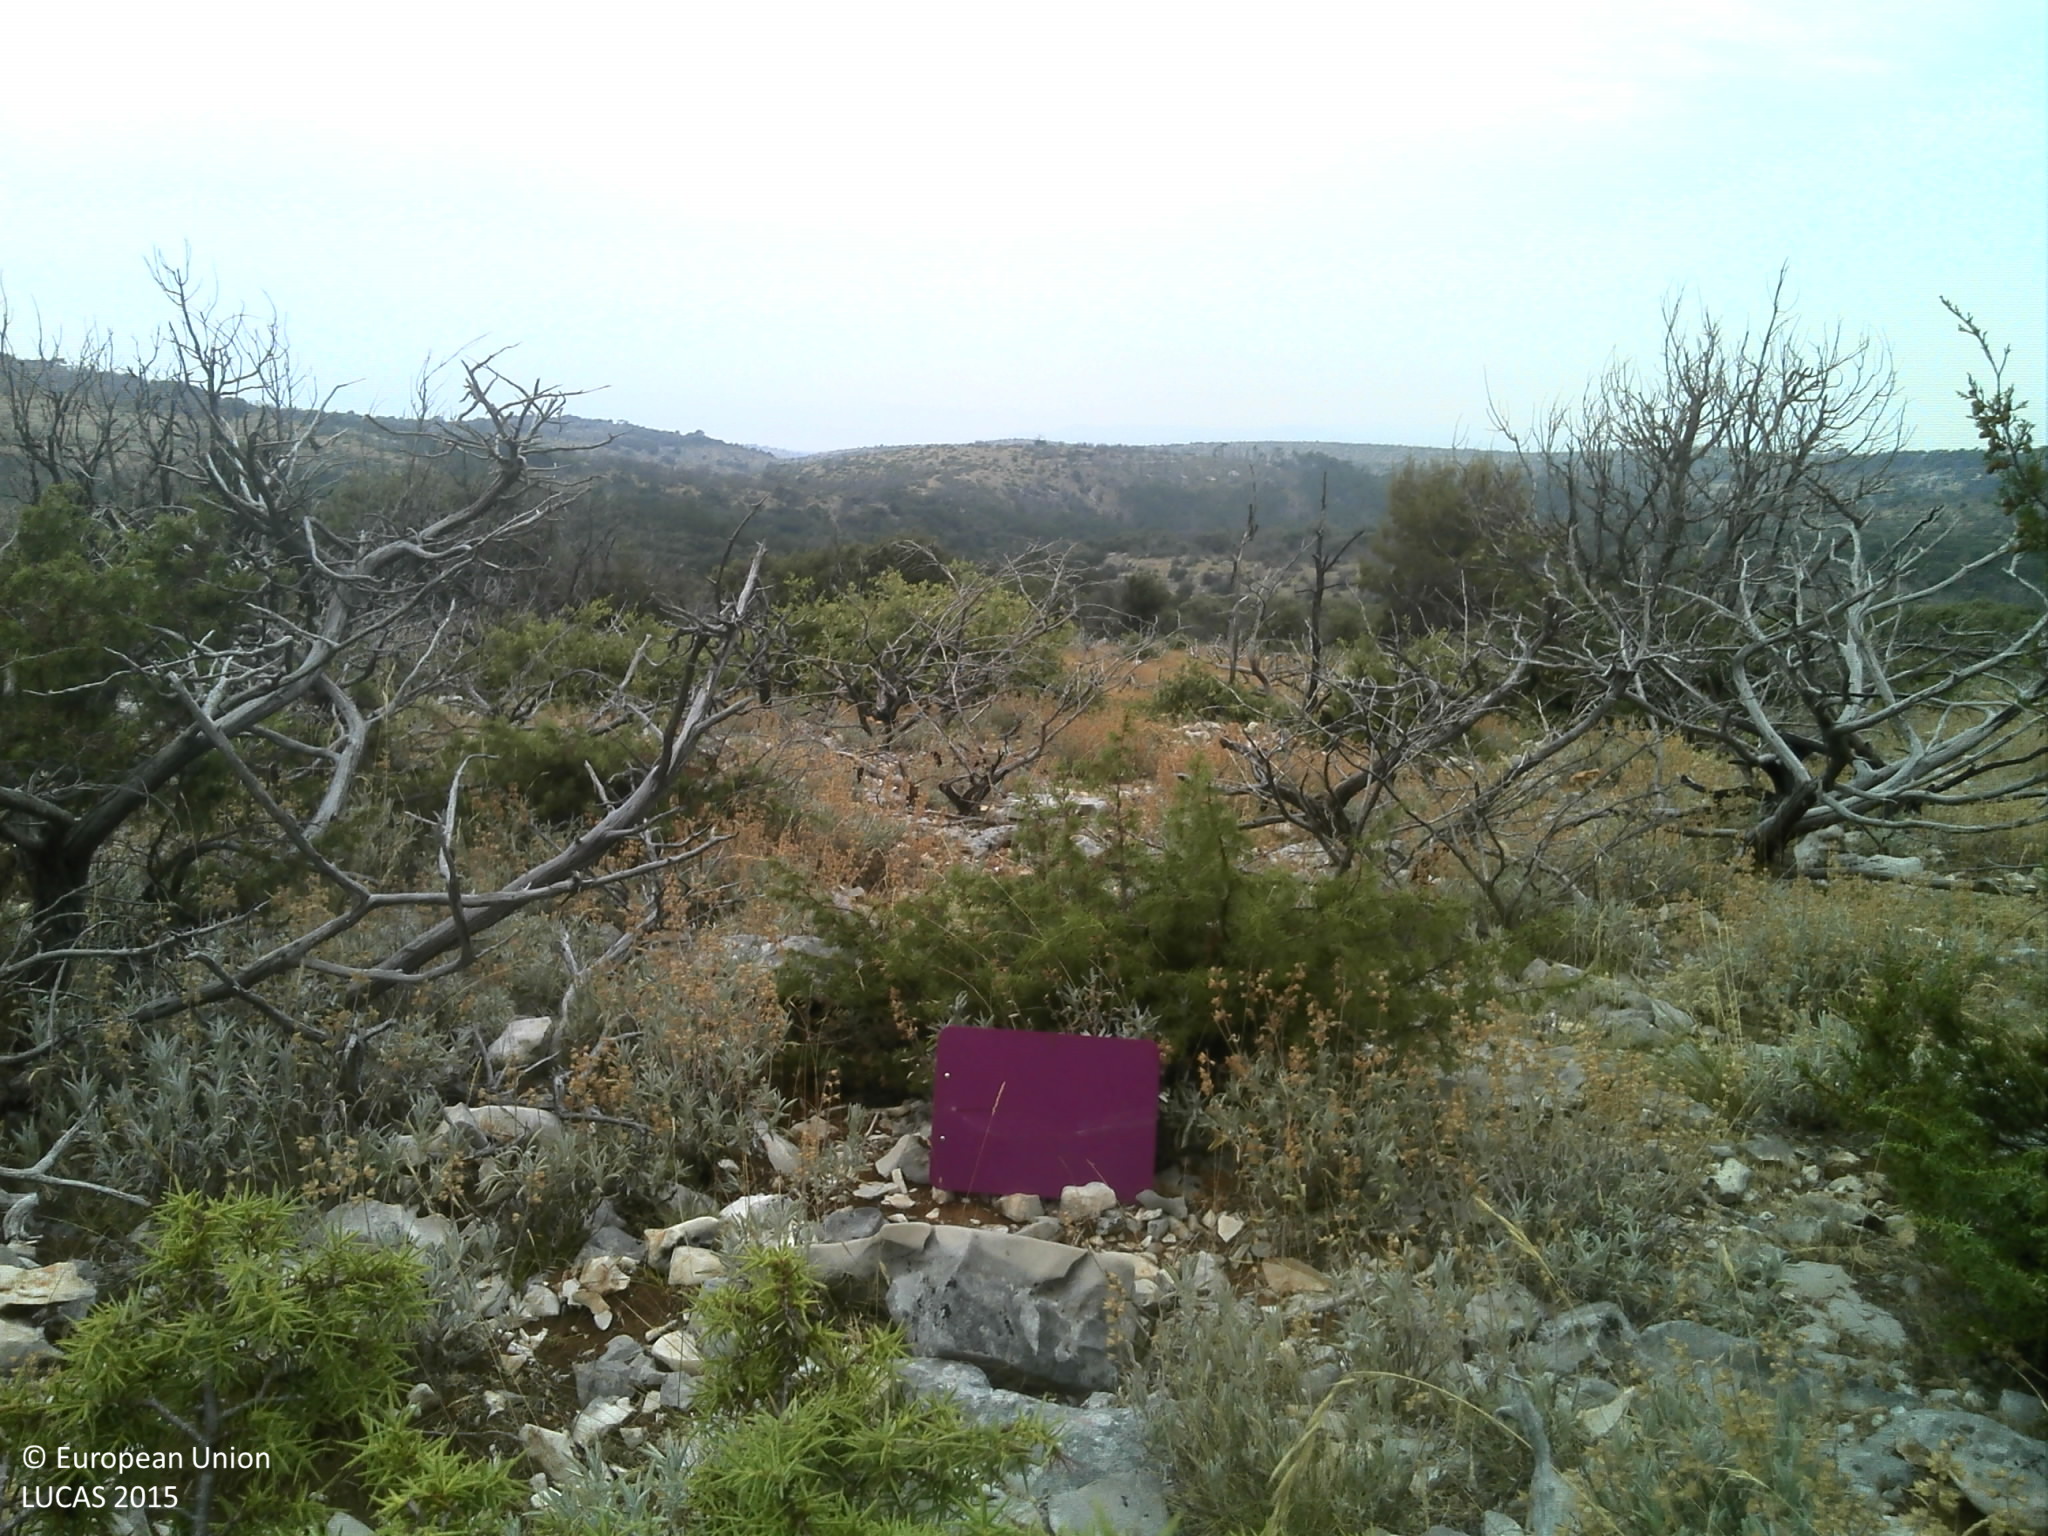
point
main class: Shrubland
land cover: Shrubland with sparse tree cover
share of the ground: > 75 %
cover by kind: shrubs 55 %, unconsolidated bare surface 20 %, herbaceous plants 15 %, broadleaved forest trees 5 %, consolidated bare surface 5 %
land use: Semi-natural and natural areas not in use
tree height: < 5 m
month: July
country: HR
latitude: 43.3104
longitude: 16.5614
